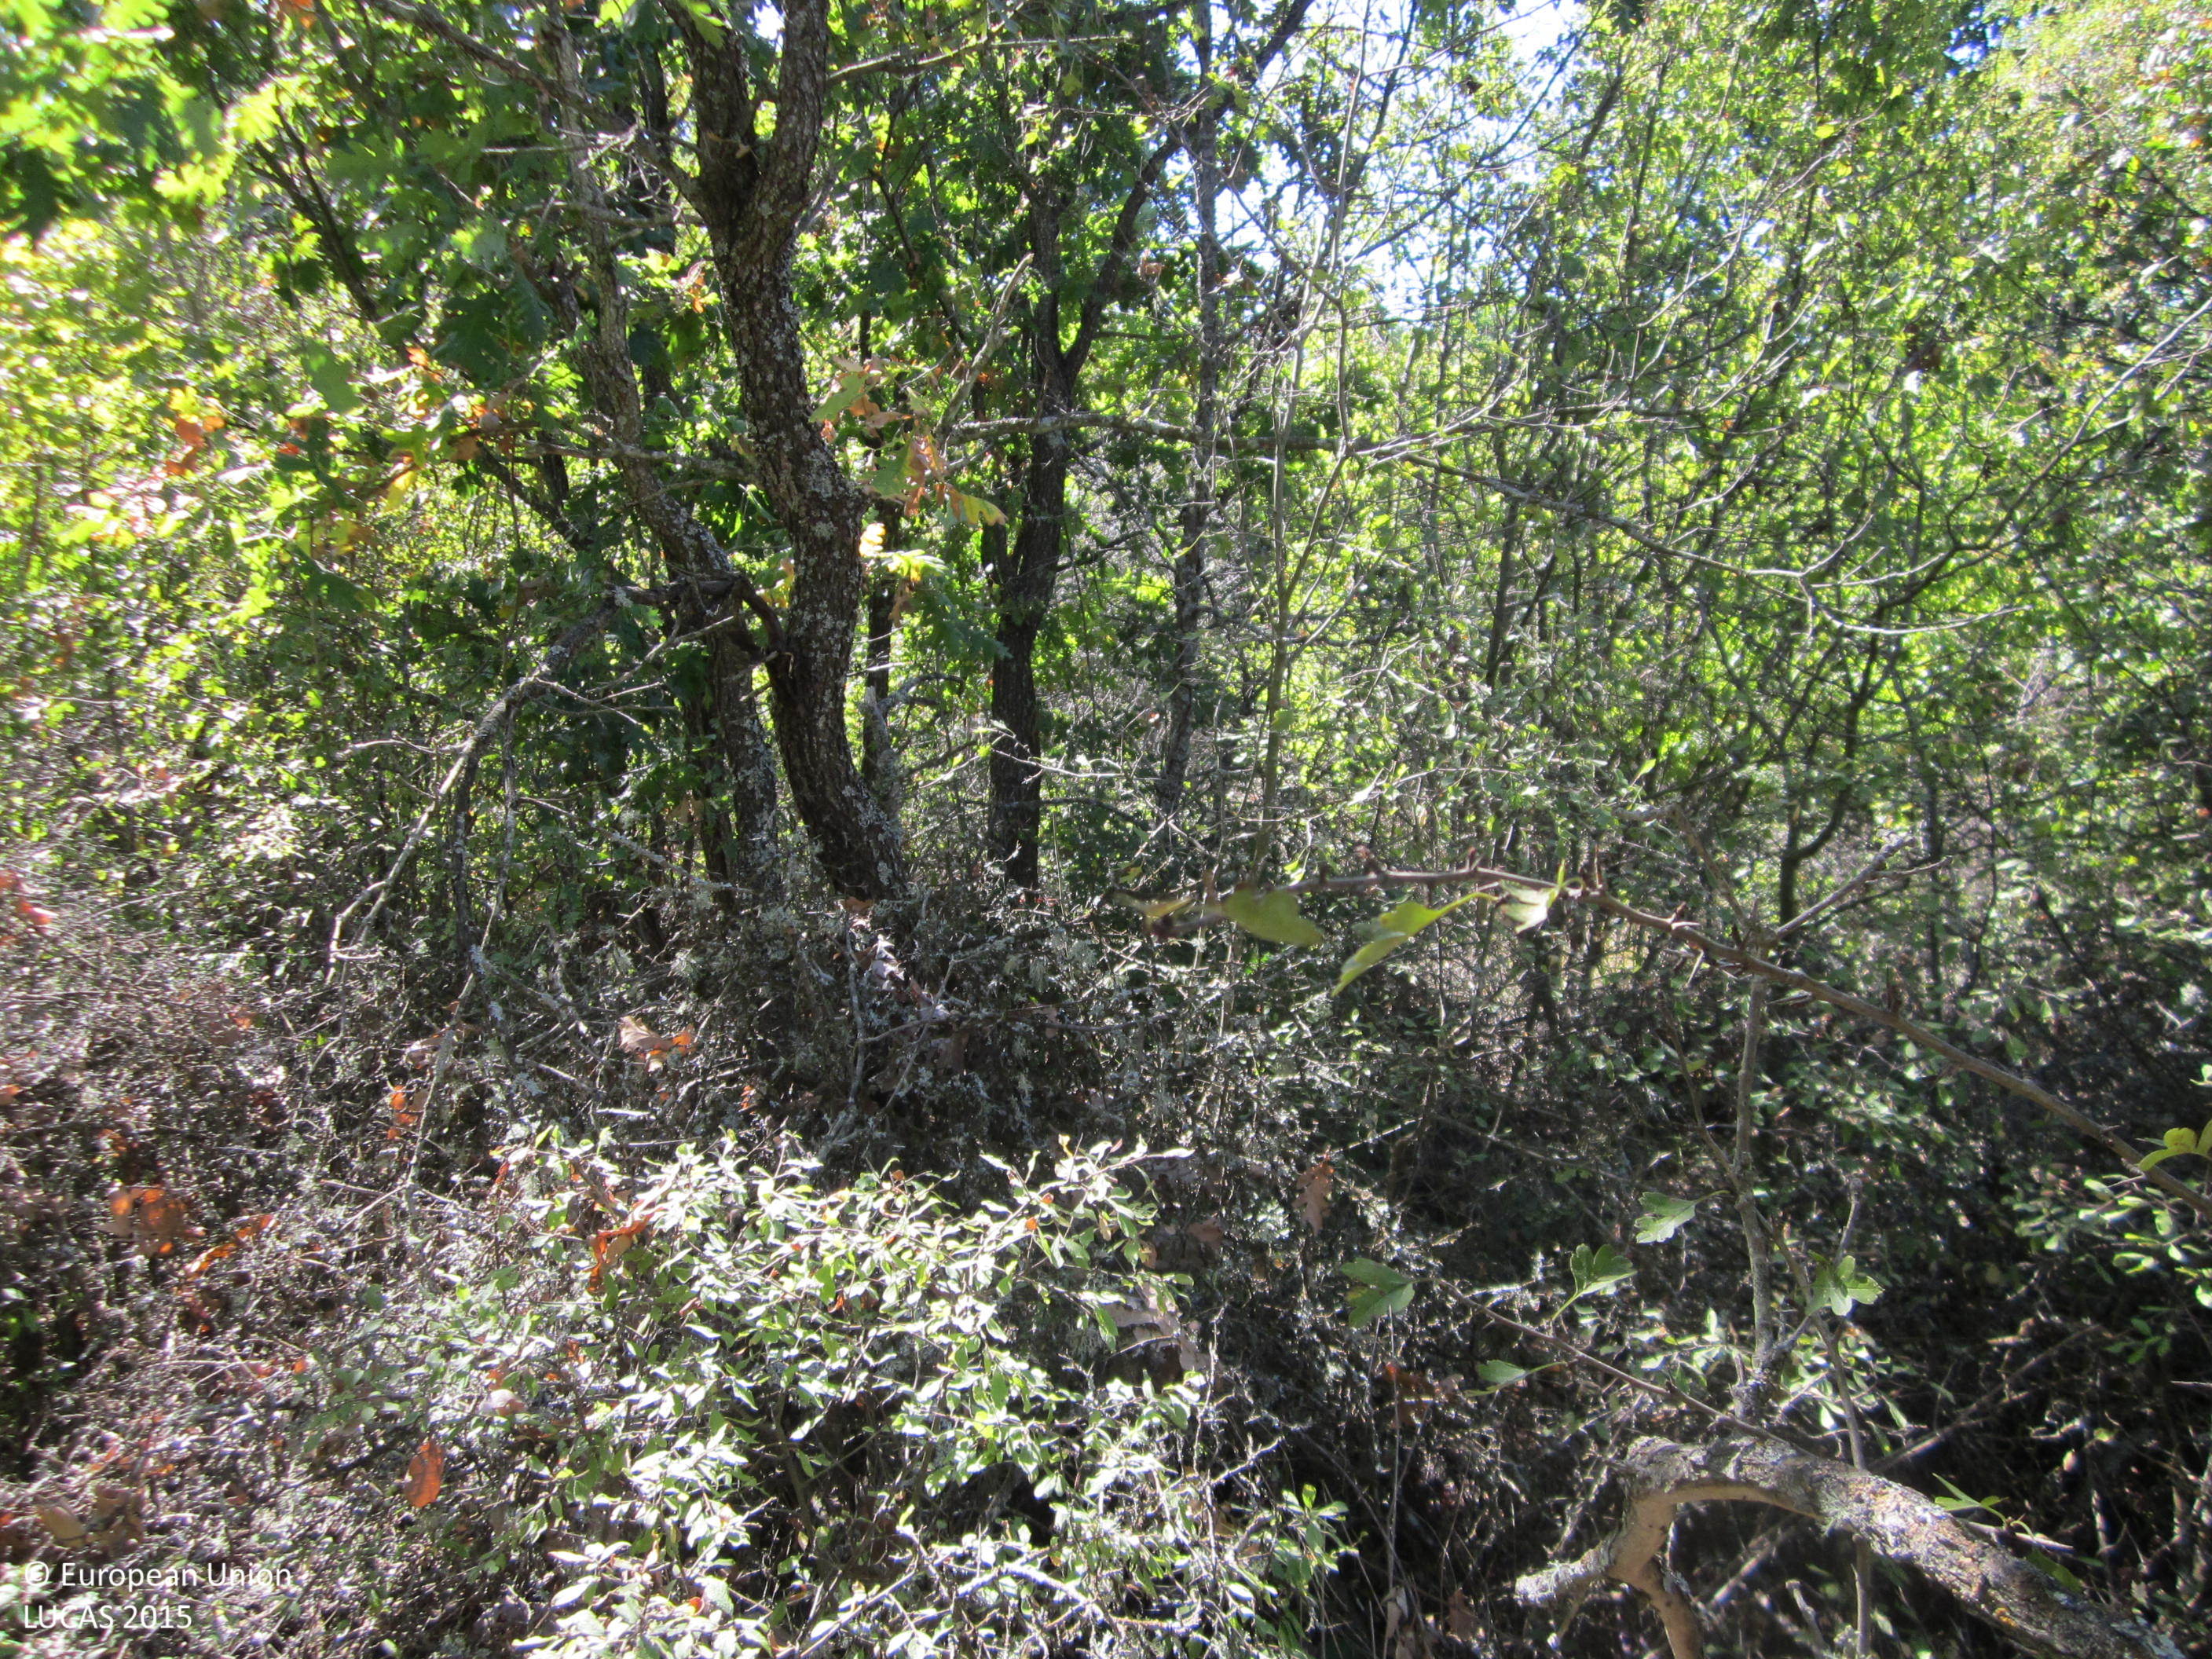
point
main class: Woodland
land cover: Broadleaved woodland
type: thermophilous deciduous forest
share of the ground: > 75 %
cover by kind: broadleaved forest trees 90 %, shrubs 5 %, herbaceous plants 5 %
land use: Forestry
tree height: > 5 m
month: September
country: BG
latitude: 42.2700
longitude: 27.0151
